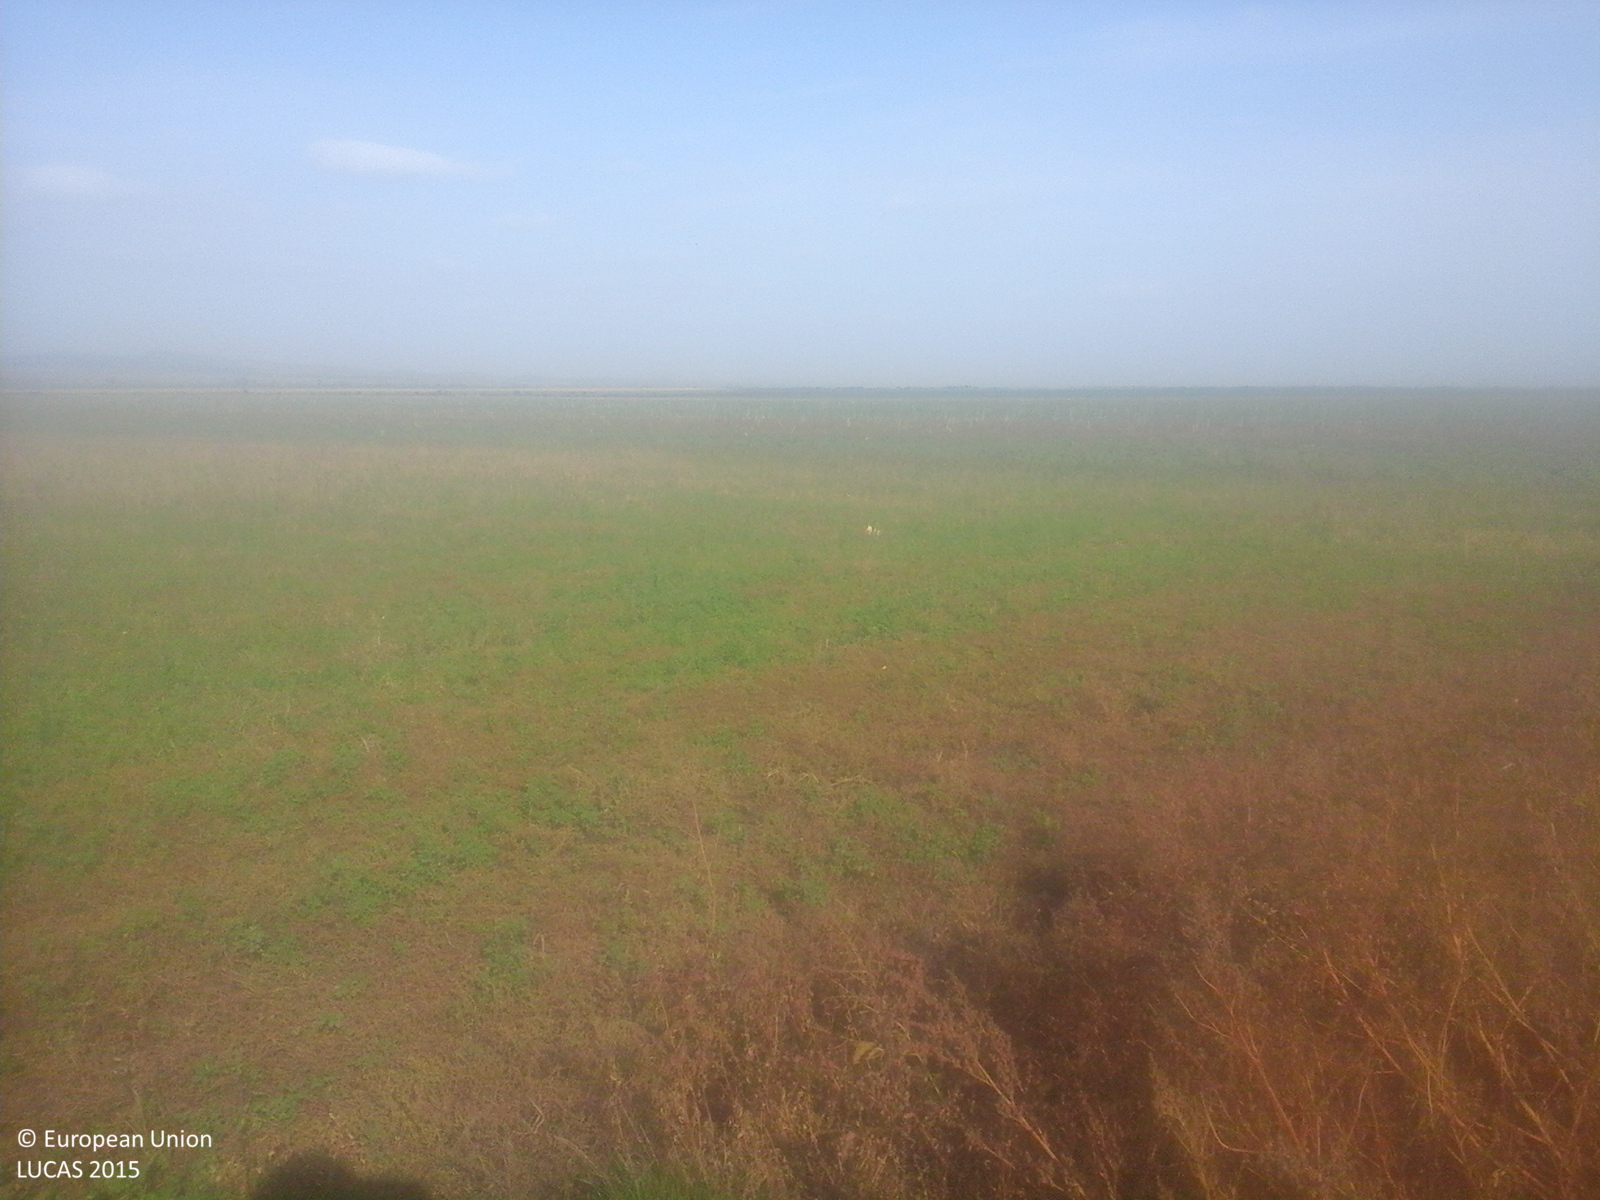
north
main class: Grassland
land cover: Spontaneously vegetated surfaces
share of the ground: > 75 %
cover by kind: herbaceous plants 100 %
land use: Agriculture (excluding fallow land and kitchen gardens)
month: October
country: RO
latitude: 45.4034
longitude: 27.0943
